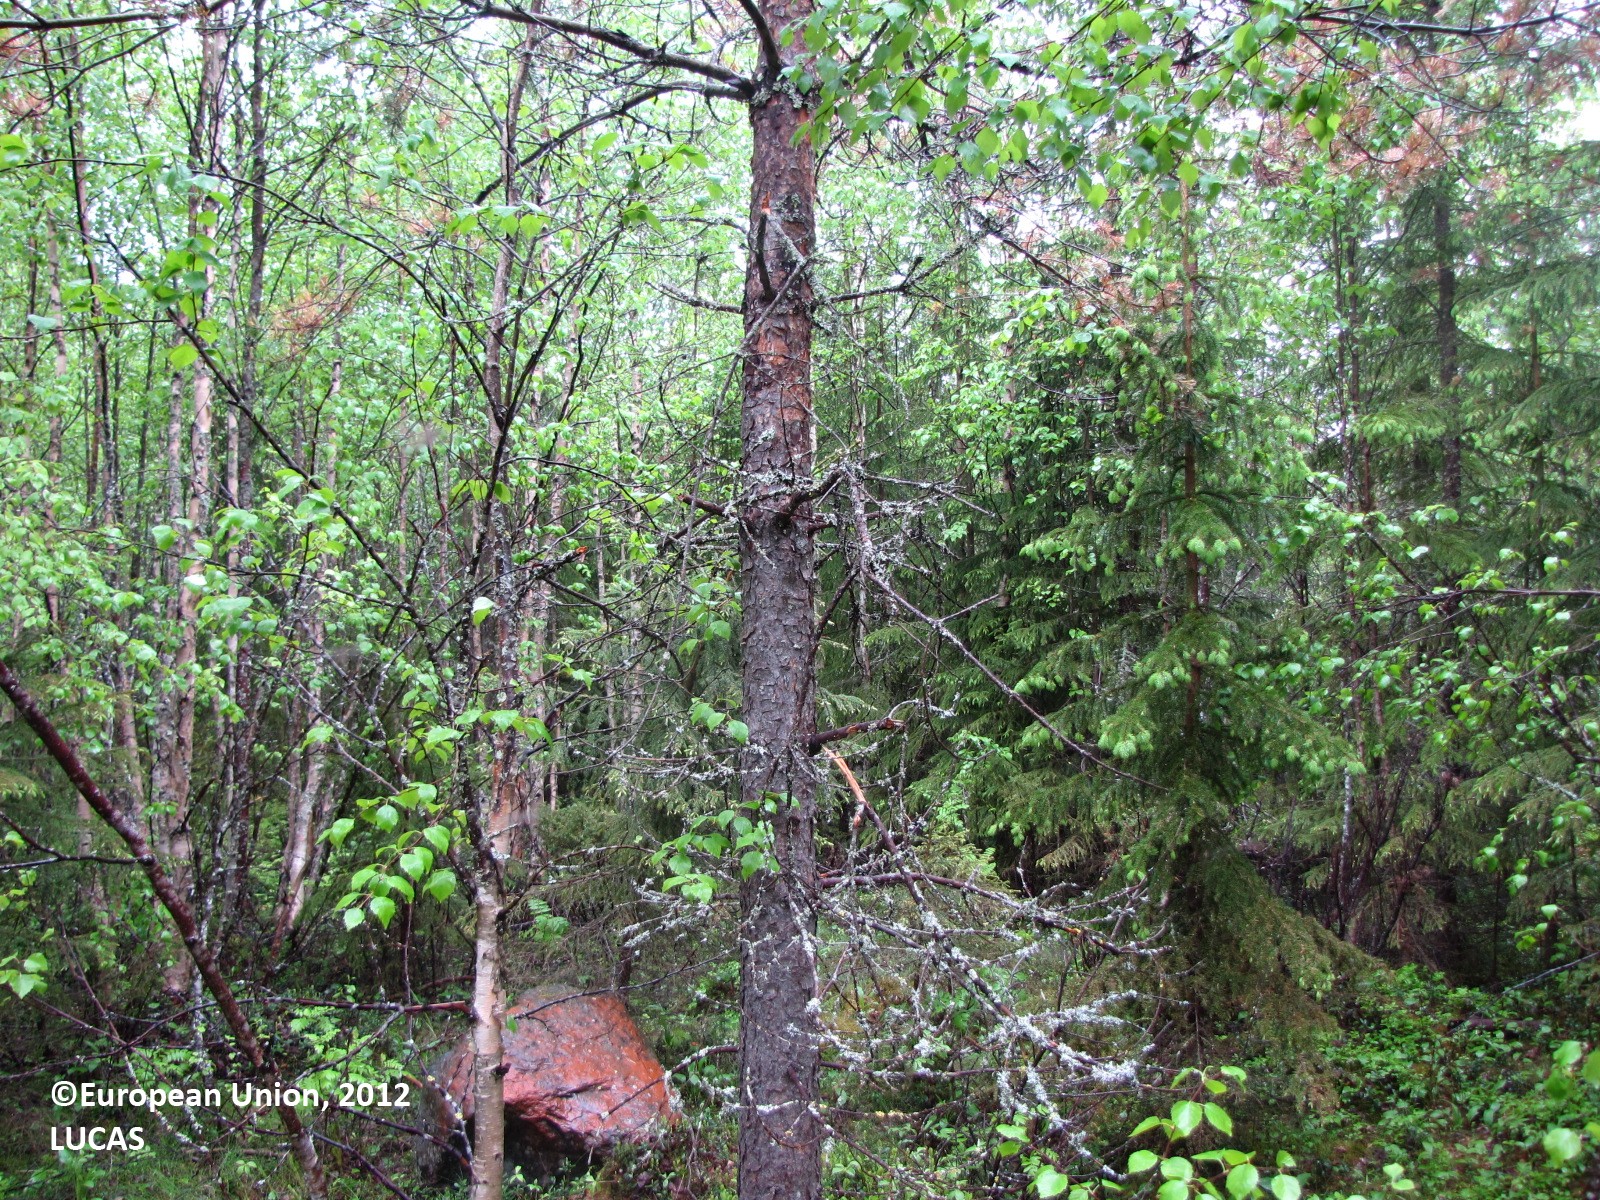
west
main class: Woodland
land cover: Other mixed woodland
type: boreal forest
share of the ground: 50 - 75 %
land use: Forestry
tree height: > 5 m
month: June
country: FI
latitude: 66.0521
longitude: 24.2873
